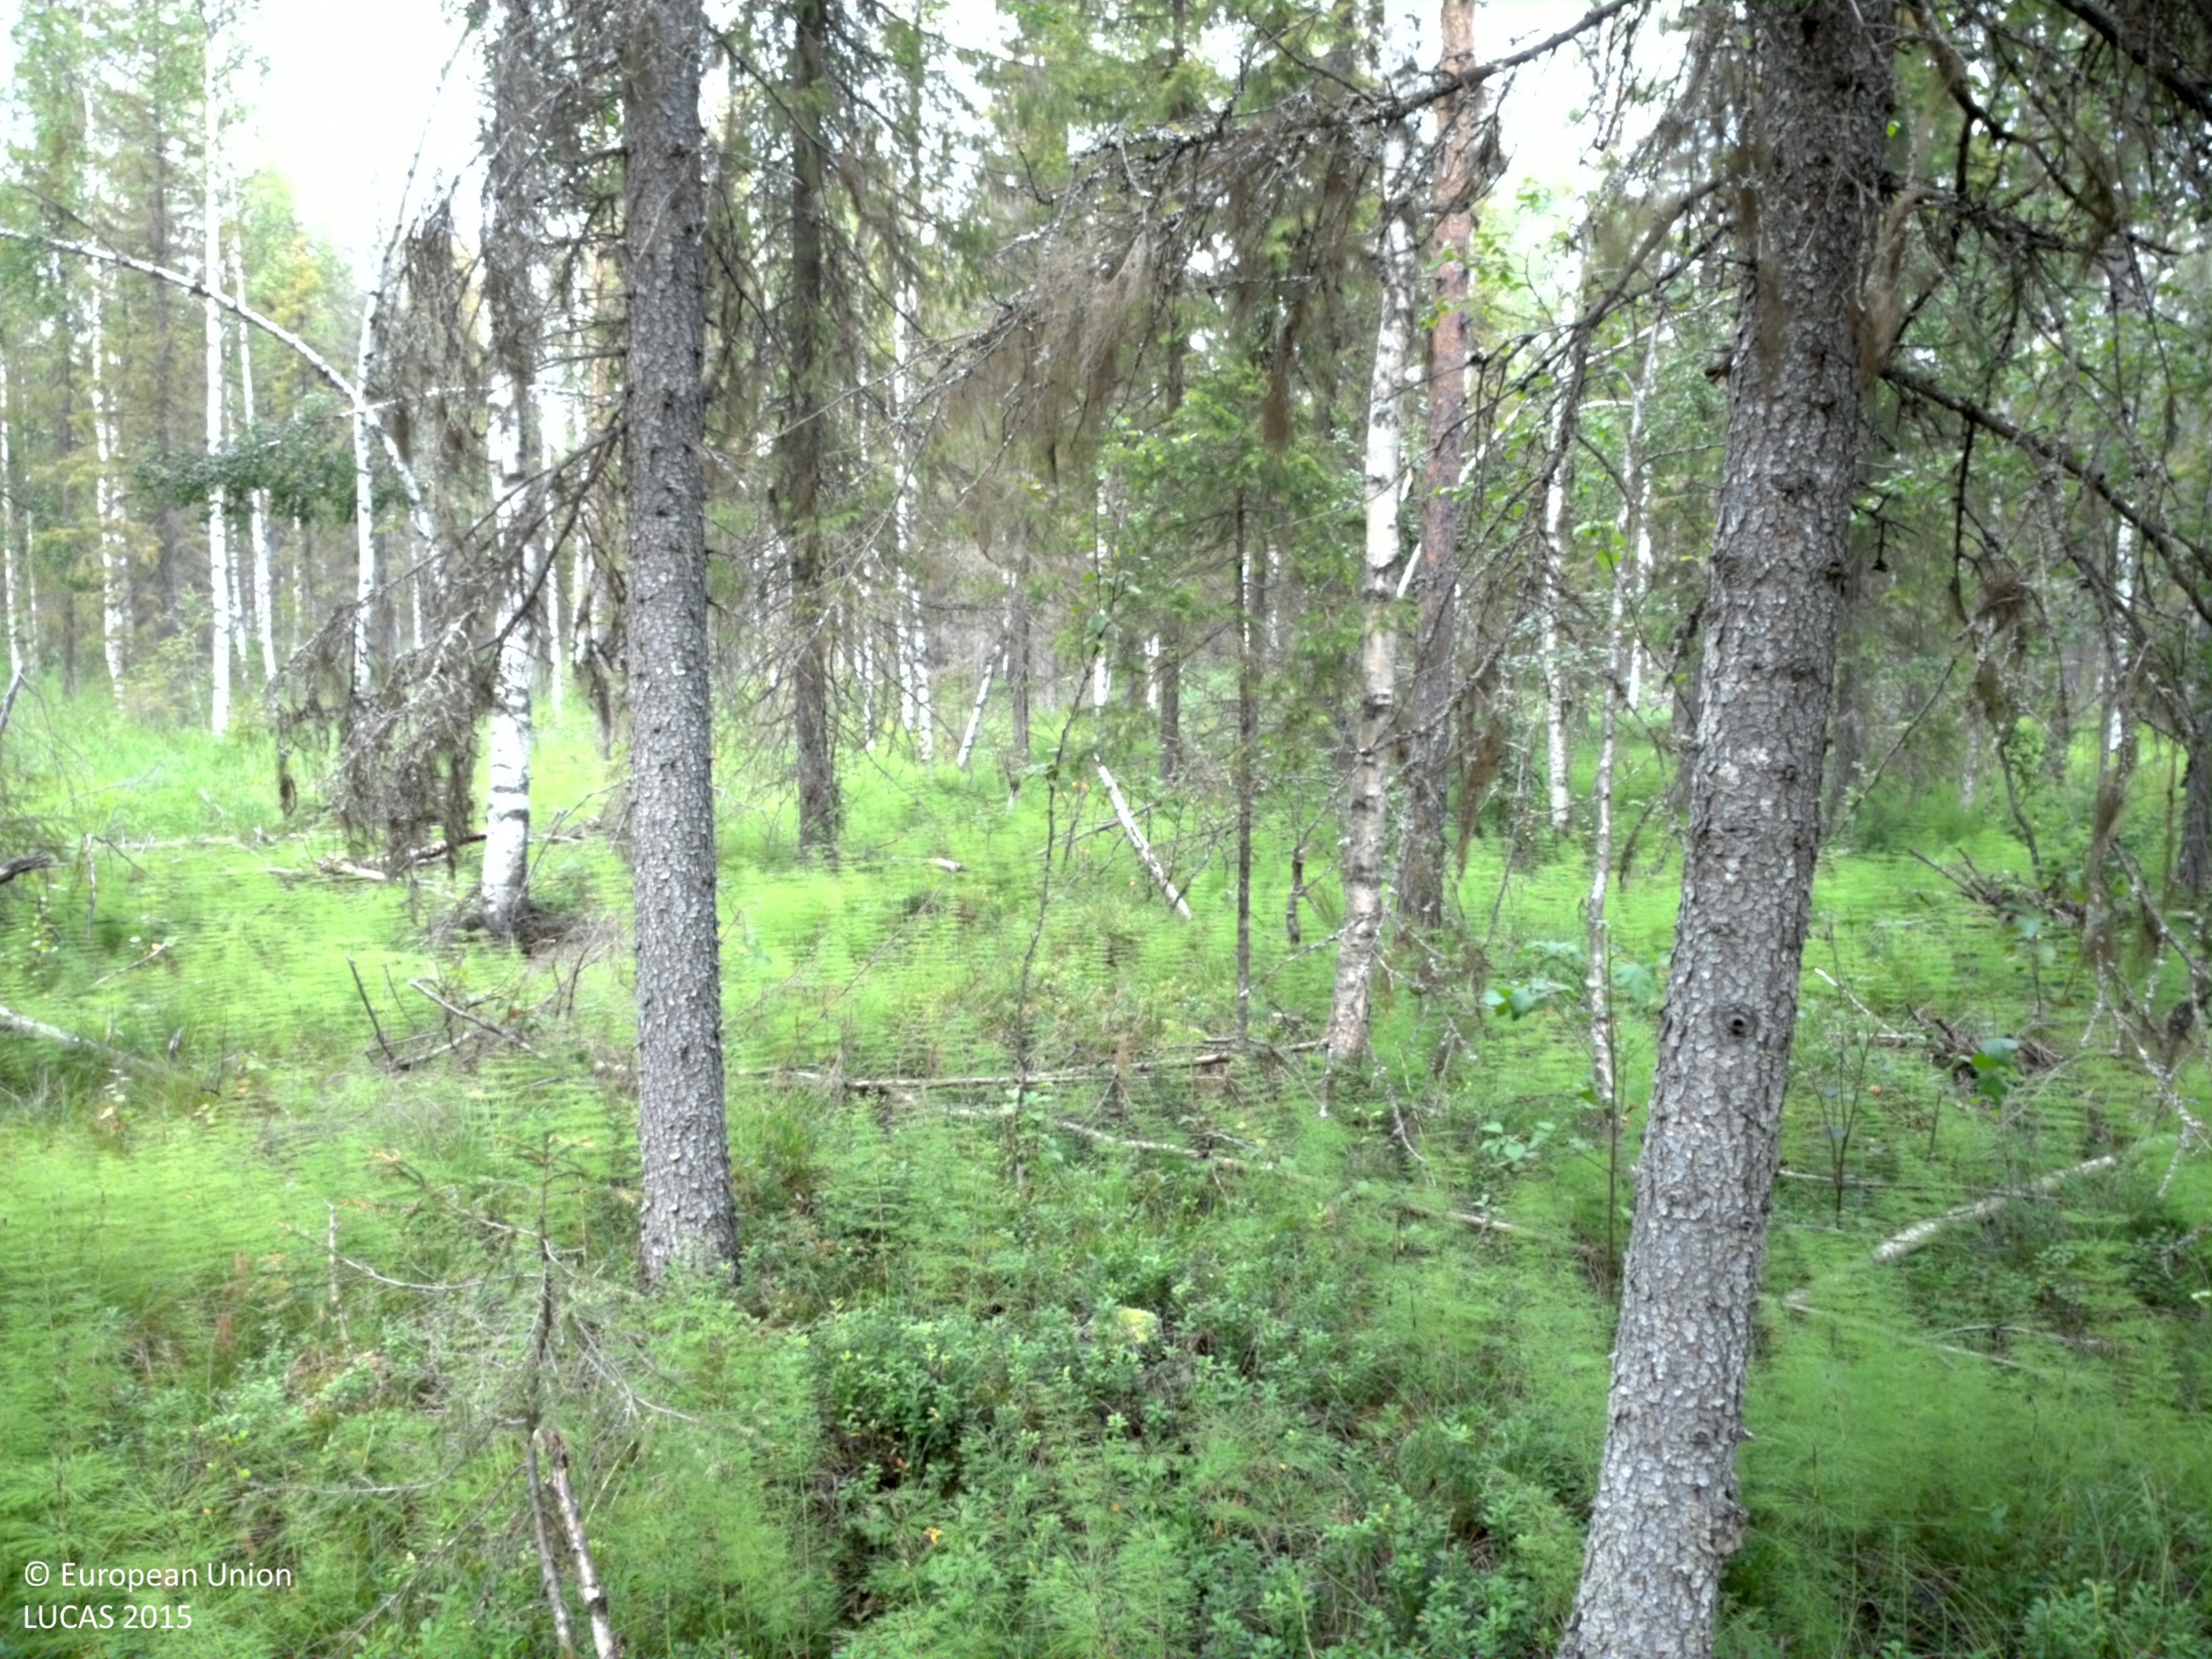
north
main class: Woodland
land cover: Spruce dominated mixed woodland
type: boreal forest
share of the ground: 25 - 50 %
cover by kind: shrubs 55 %, coniferous forest trees 30 %, broadleaved forest trees 10 %, lichens and mosses 5 %
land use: Forestry
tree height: > 5 m
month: August
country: SE
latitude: 65.9298
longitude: 22.6149
